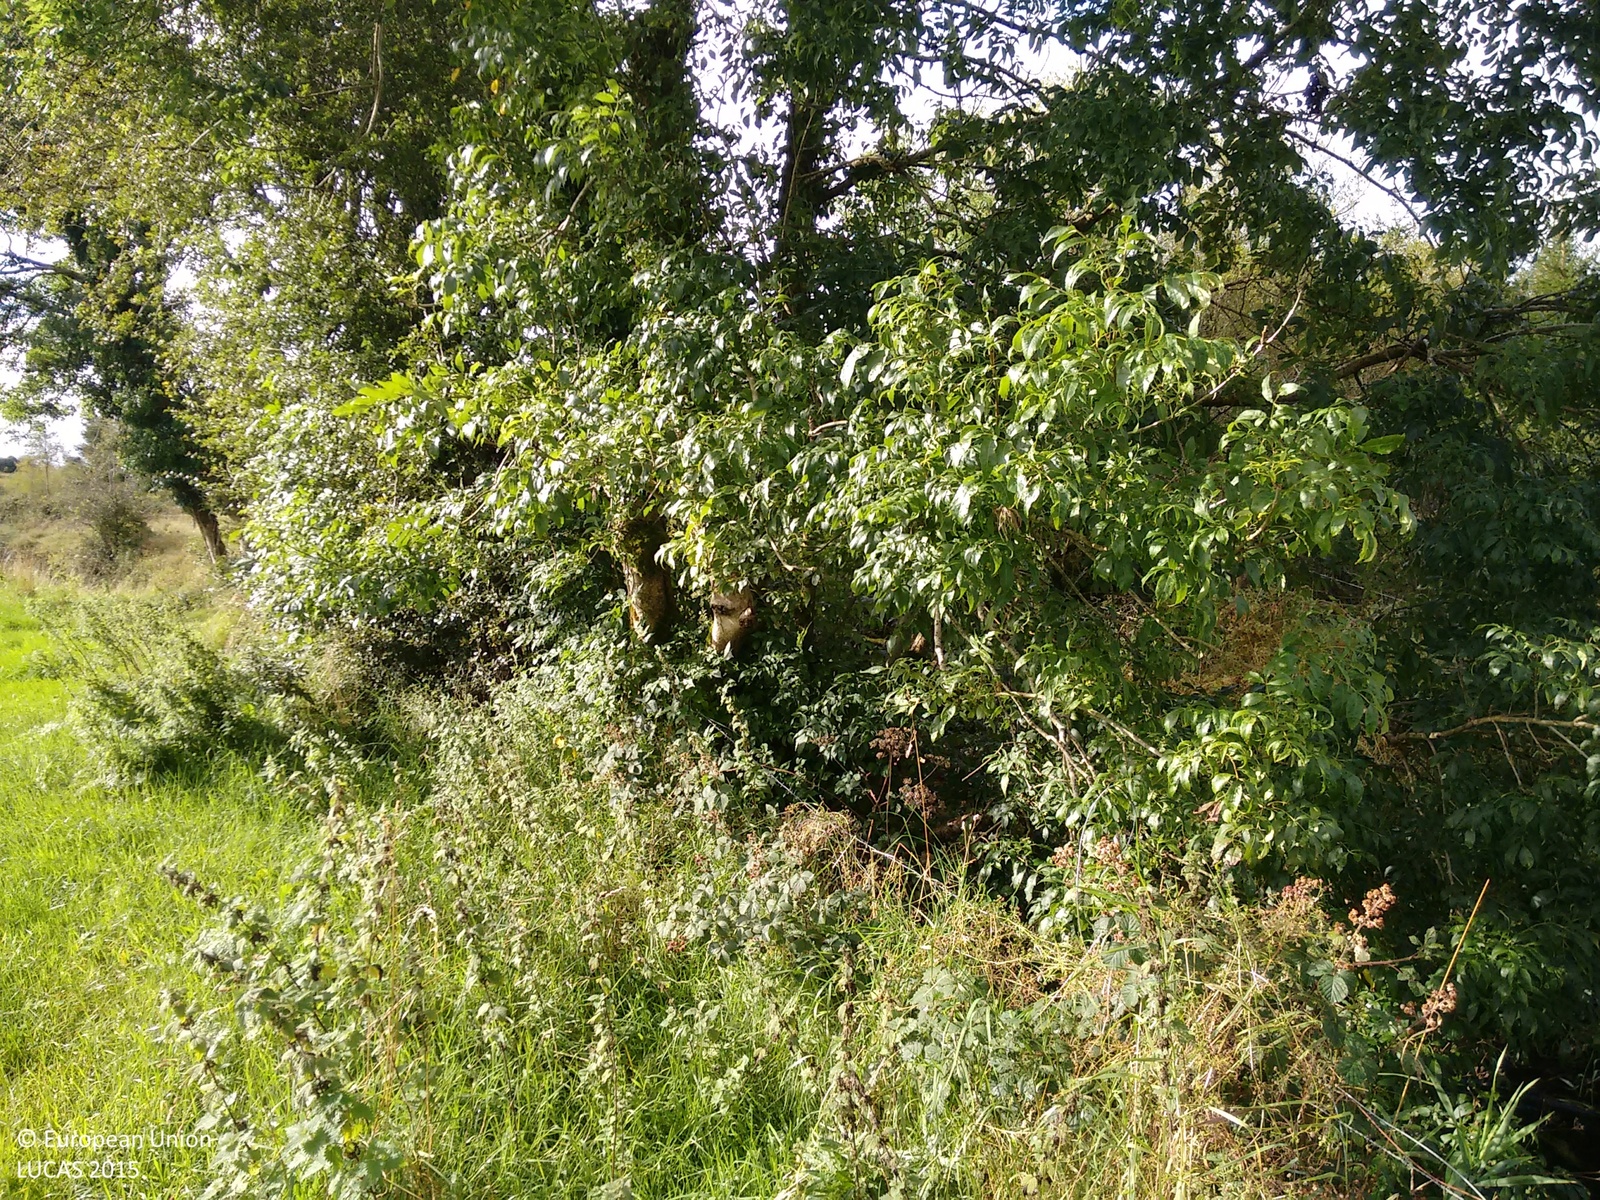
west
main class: Woodland
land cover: Broadleaved woodland
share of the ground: > 75 %
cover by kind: broadleaved forest trees 75 %, herbaceous plants 25 %
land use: Agriculture (excluding fallow land and kitchen gardens)
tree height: < 5 m
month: September
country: IE
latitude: 53.7443
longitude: -8.7778
